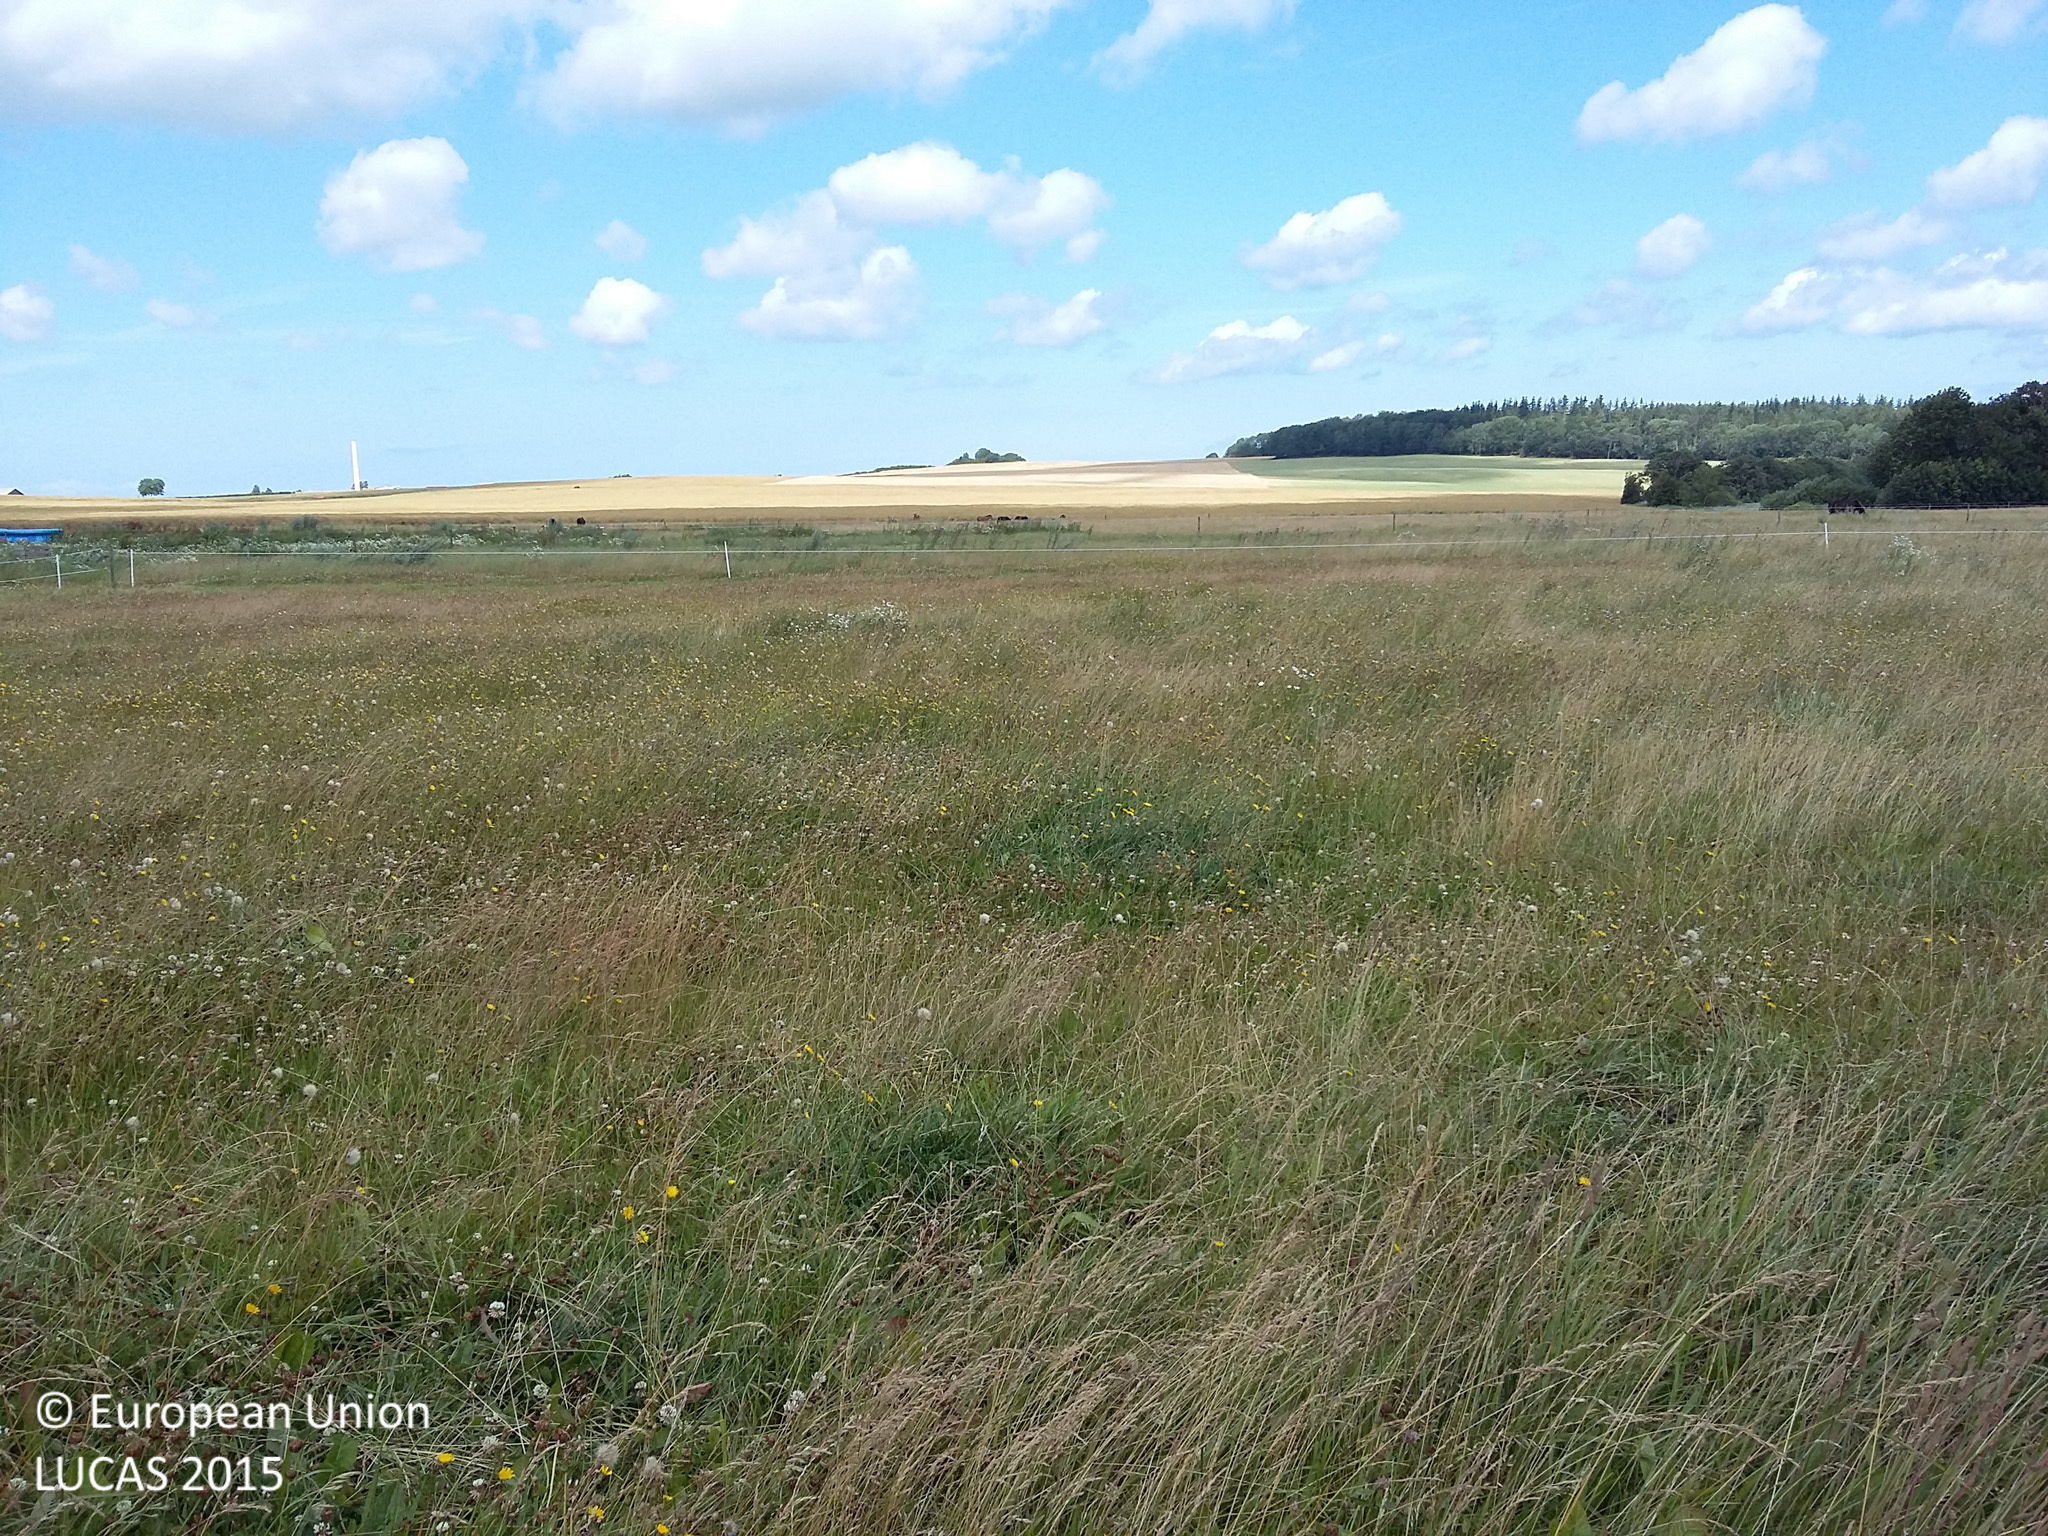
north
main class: Grassland
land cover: Grassland without tree/shrub cover
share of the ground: > 75 %
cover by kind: herbaceous plants 100 %
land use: Agriculture (excluding fallow land and kitchen gardens)
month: July
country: DK
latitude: 55.7625
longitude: 11.7355
